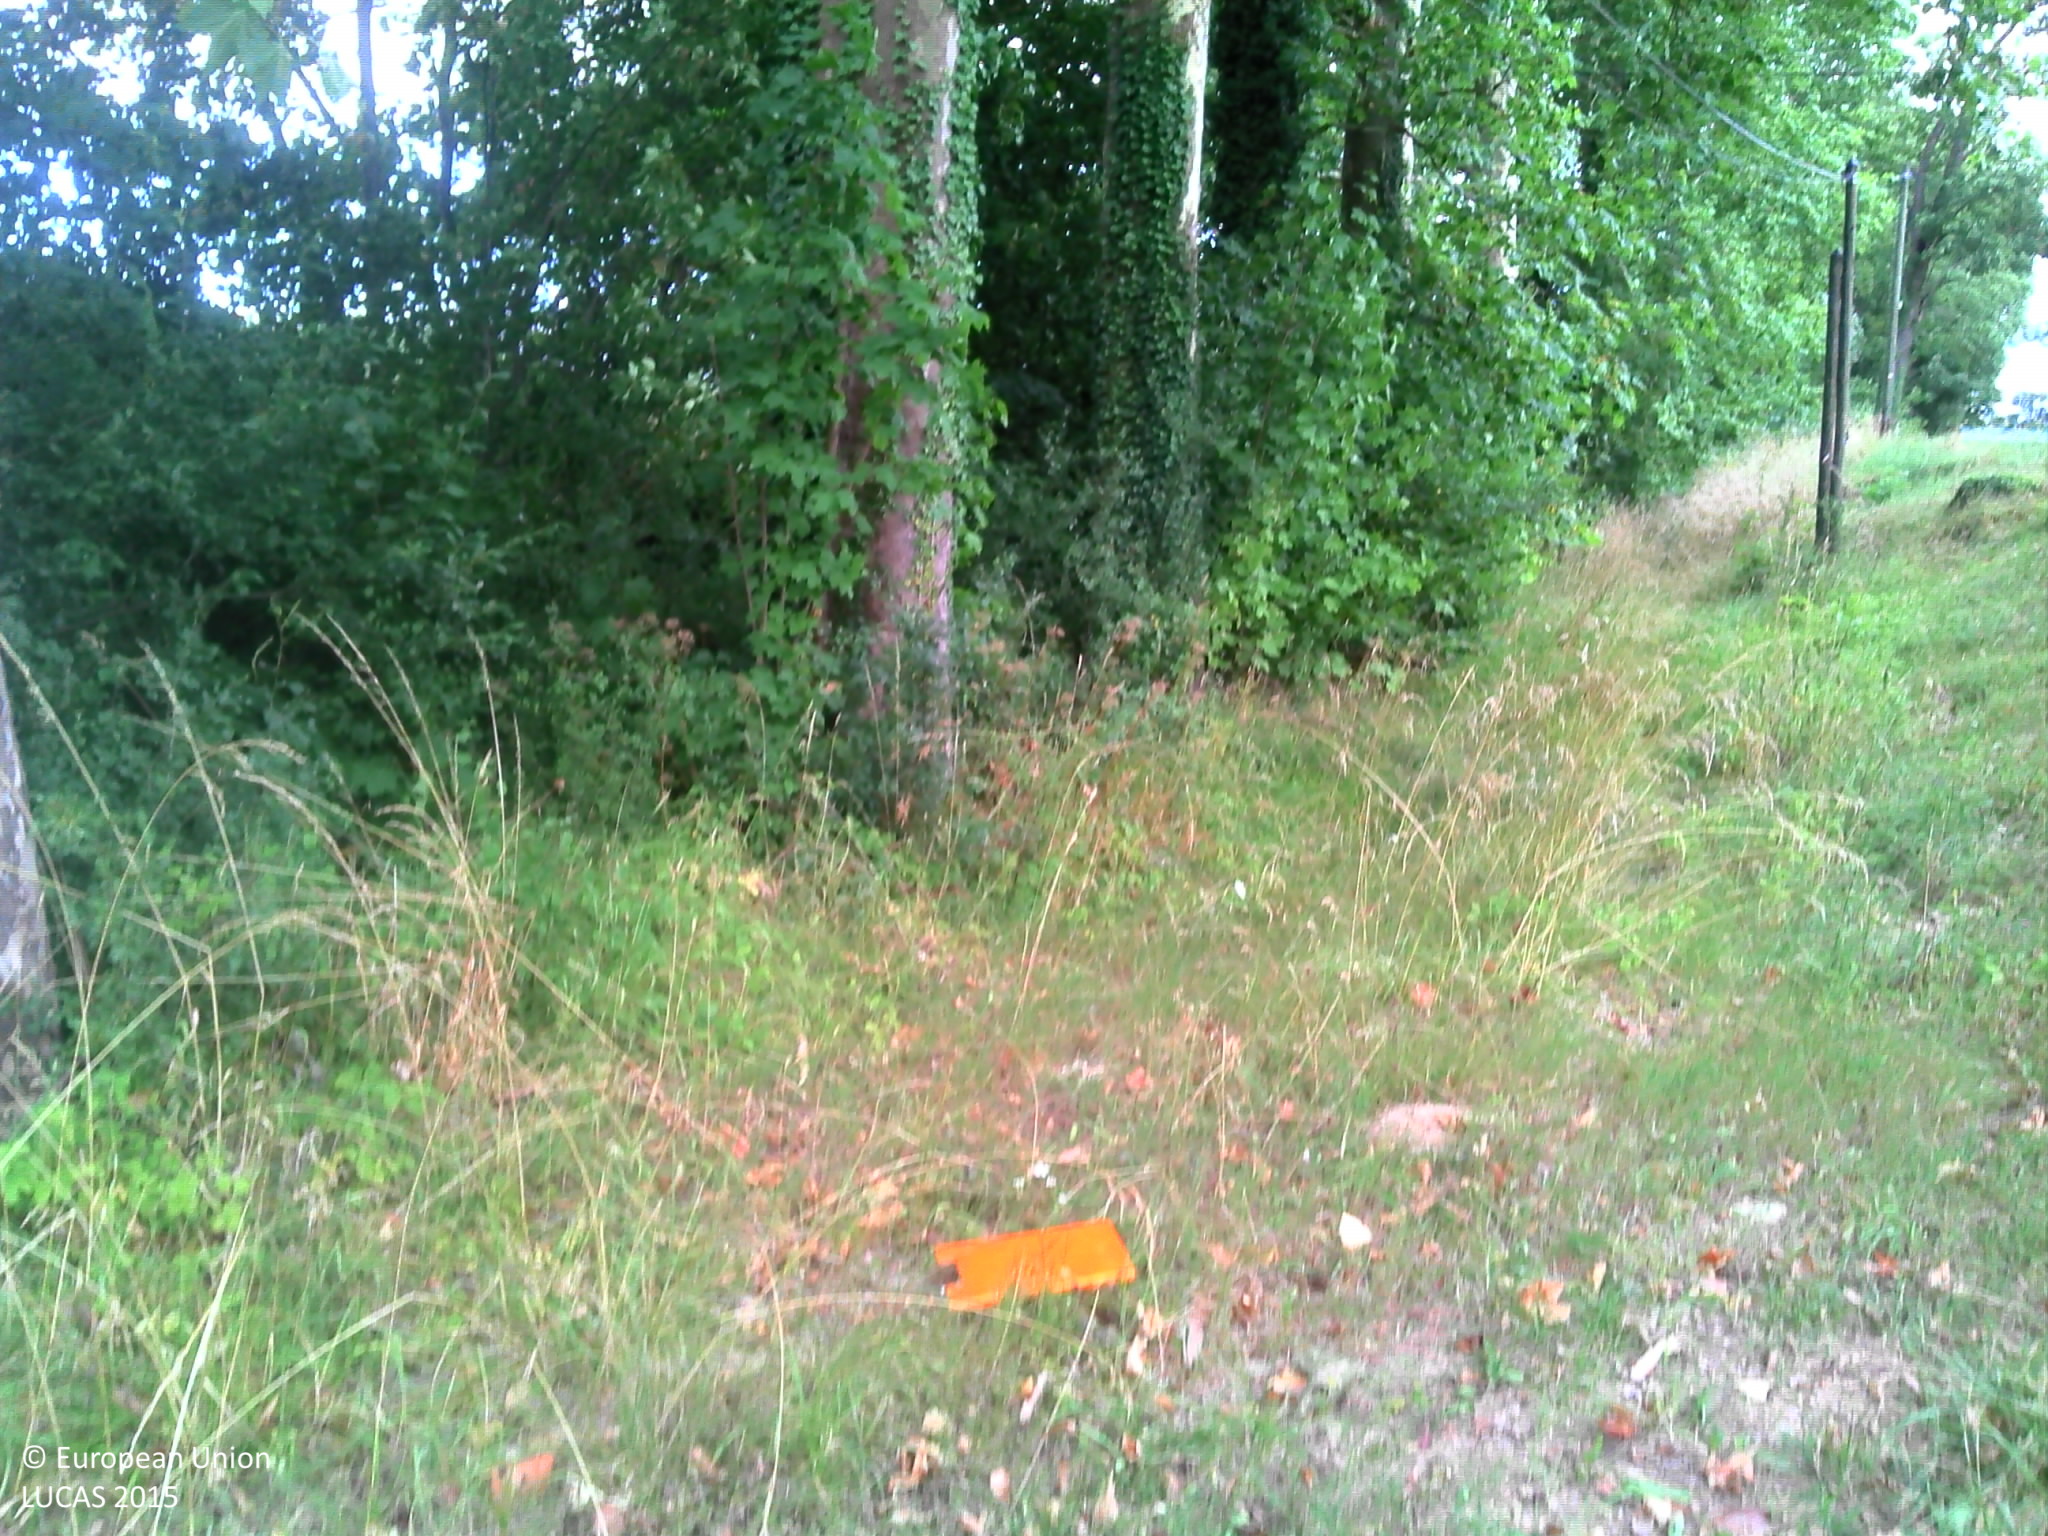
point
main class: Grassland
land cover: Grassland without tree/shrub cover
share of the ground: > 75 %
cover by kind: herbaceous plants 100 %
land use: Agriculture (excluding fallow land and kitchen gardens)
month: July
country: FR
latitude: 46.9644
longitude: 3.1755
